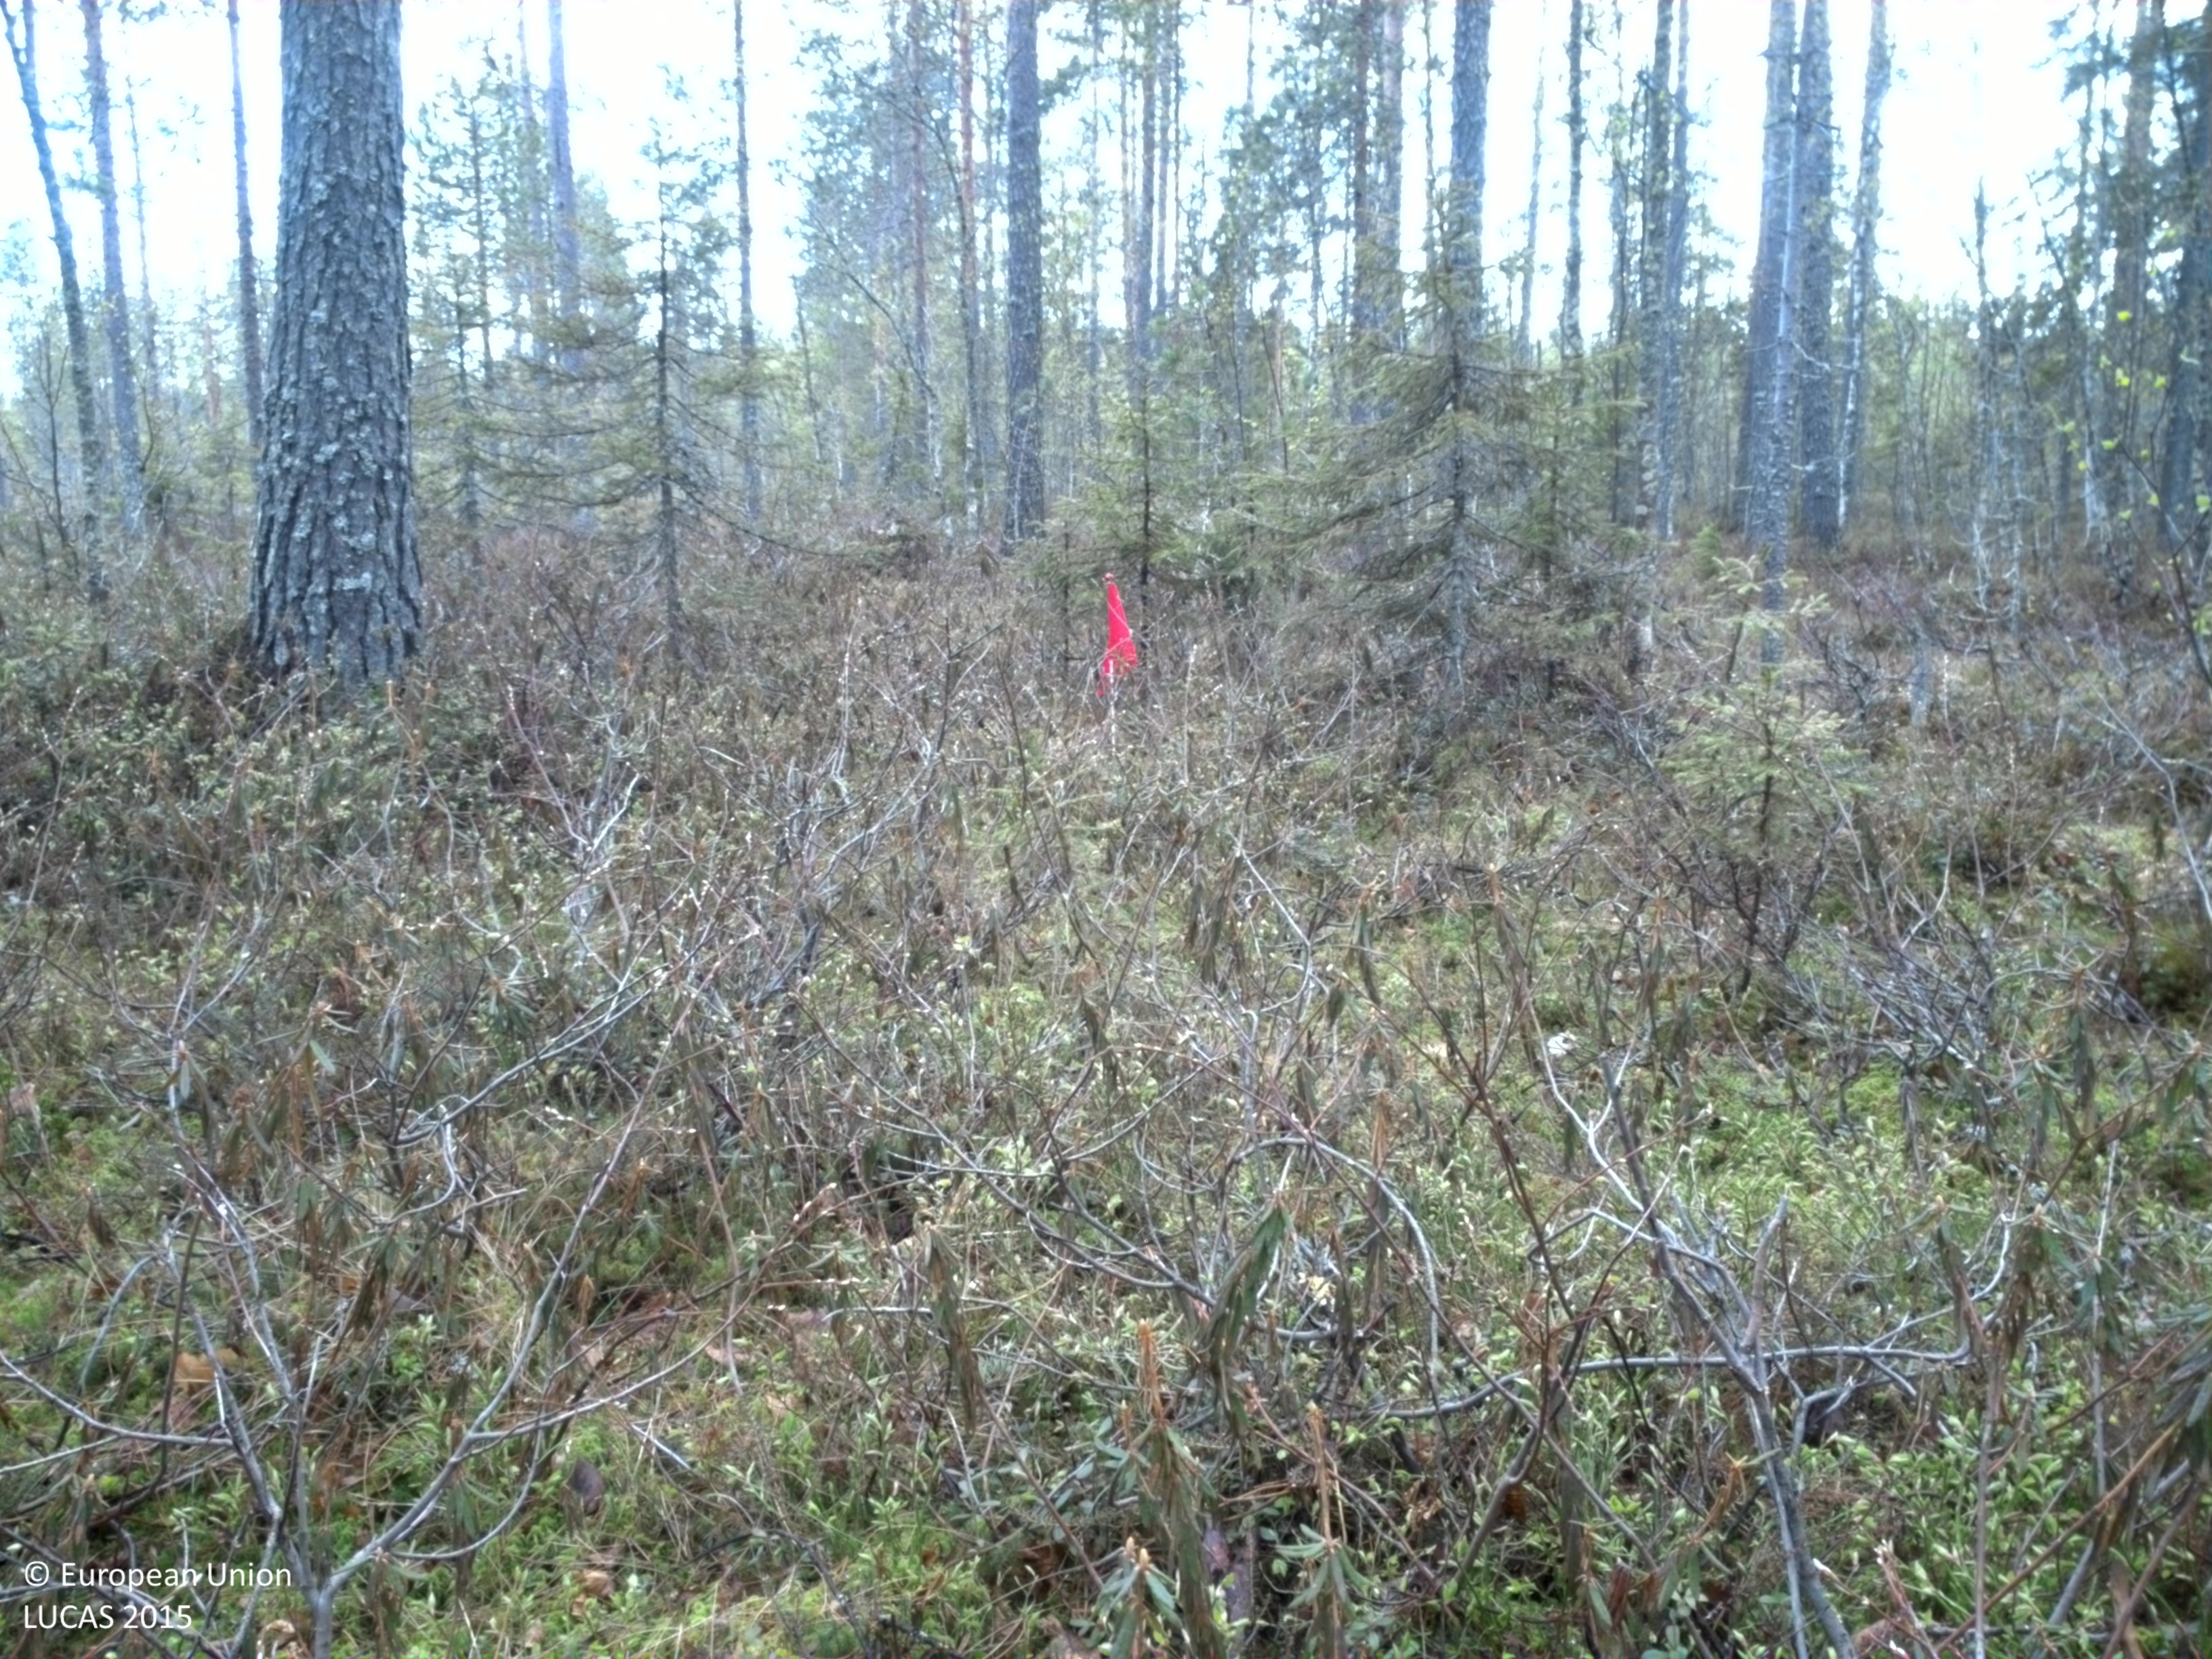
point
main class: Woodland
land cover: Pine dominated mixed woodland
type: mire and swamp forests
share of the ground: 25 - 50 %
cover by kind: shrubs 40 %, coniferous forest trees 25 %, broadleaved forest trees 25 %, herbaceous plants 5 %, lichens and mosses 5 %
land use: Forestry
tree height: > 5 m
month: May
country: SE
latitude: 66.0525
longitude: 23.1666
